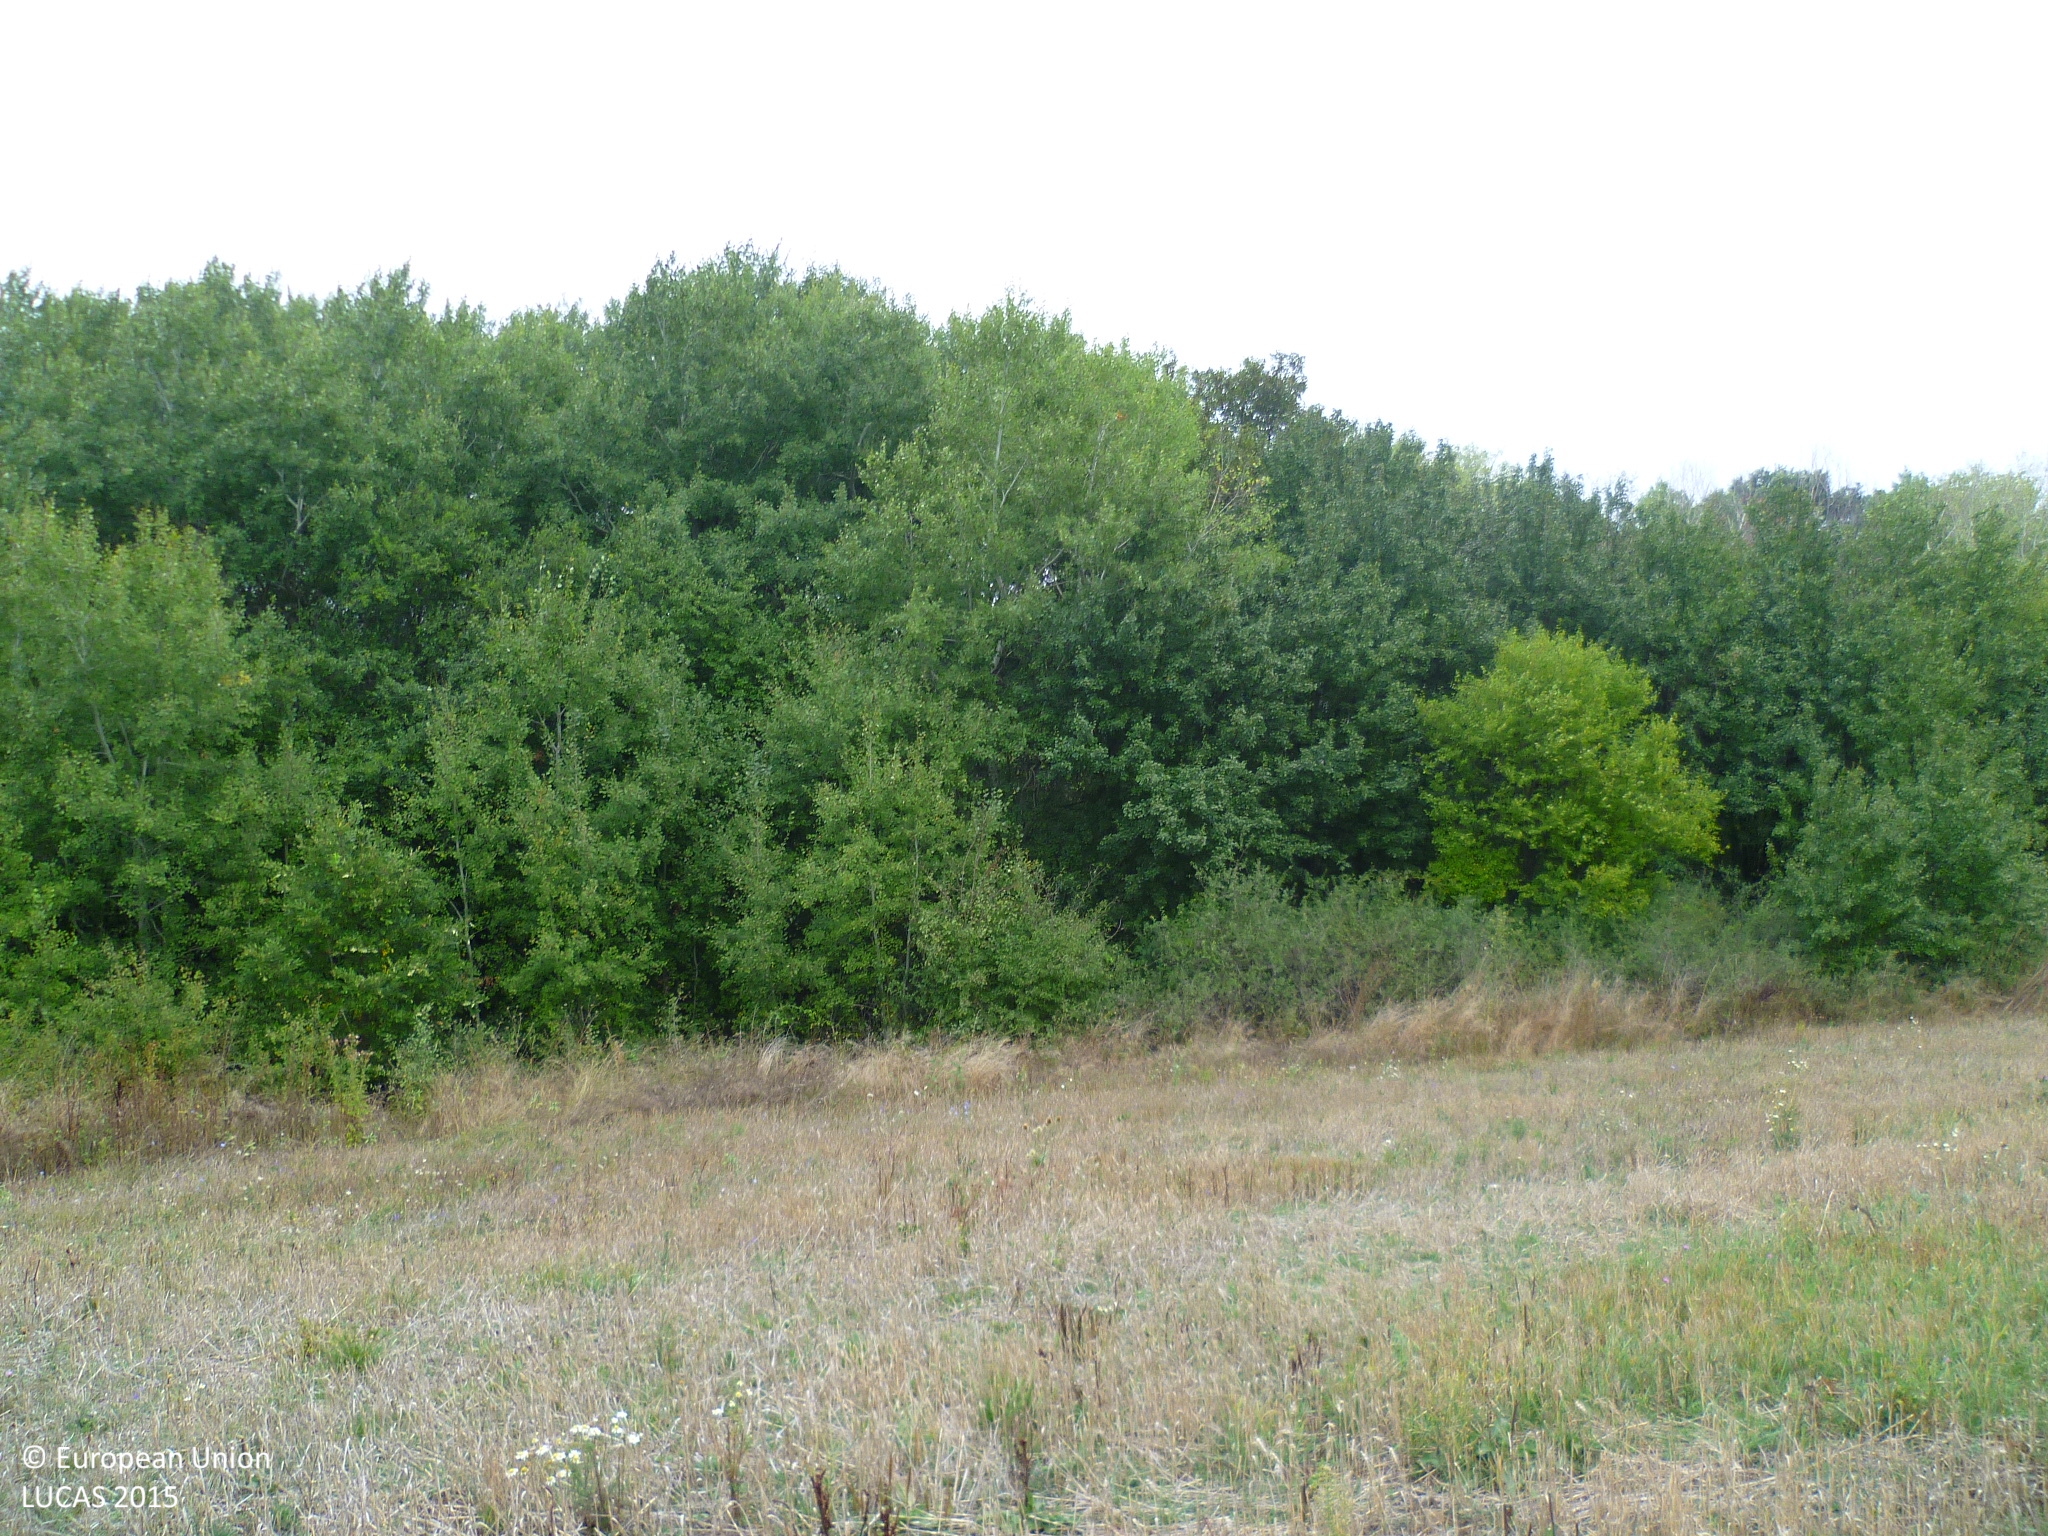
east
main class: Cropland
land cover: Barley
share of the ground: > 75 %
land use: Agriculture (excluding fallow land and kitchen gardens)
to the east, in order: Barley; Broadleaved woodland; Rivers and streams; Broadleaved woodland; Grassland with sparse tree/shrub cover; Broadleaved woodland; Shrubland without tree cover; Electric lines; Shrubland without tree cover; Barley
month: September
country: BG
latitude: 42.8013
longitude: 22.9793
